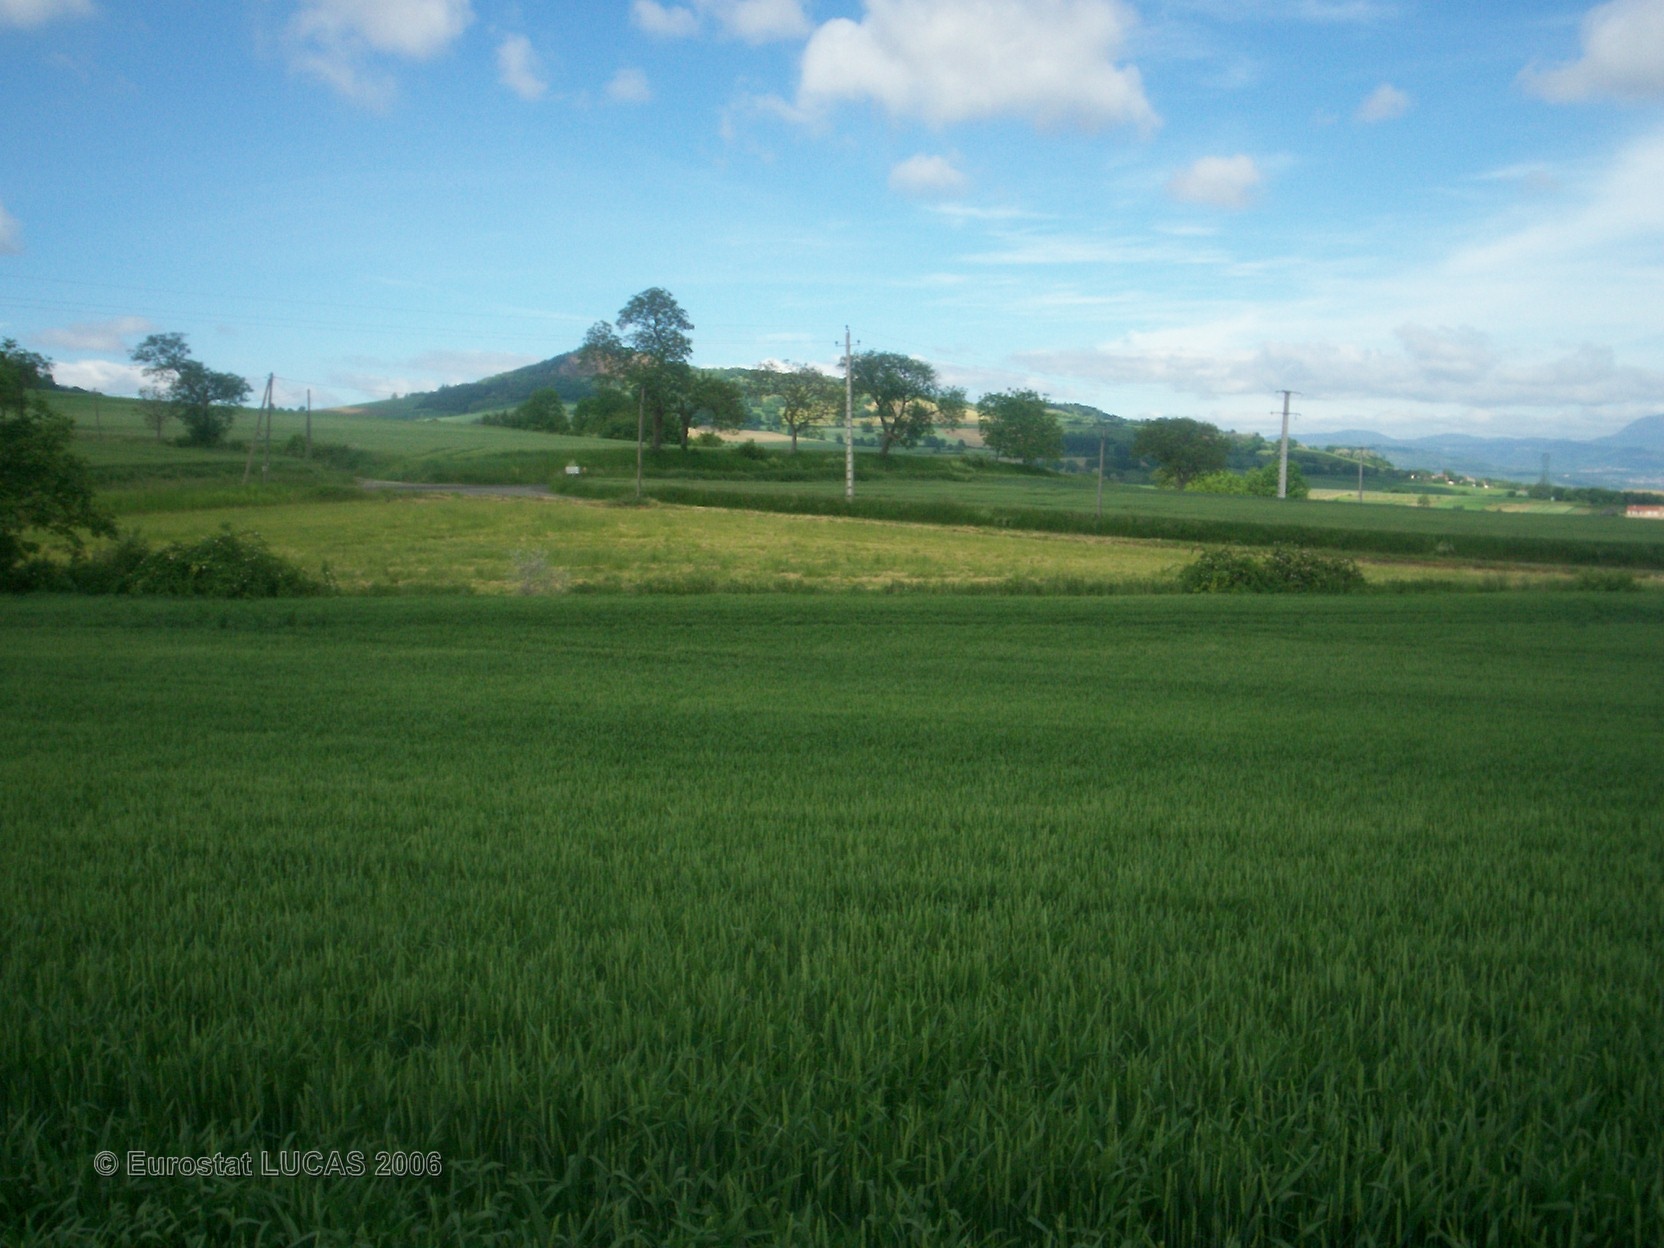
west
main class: Cropland
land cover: Common wheat
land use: Agriculture (excluding fallow land and kitchen gardens)
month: May
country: FR
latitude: 45.7062
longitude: 3.2828
